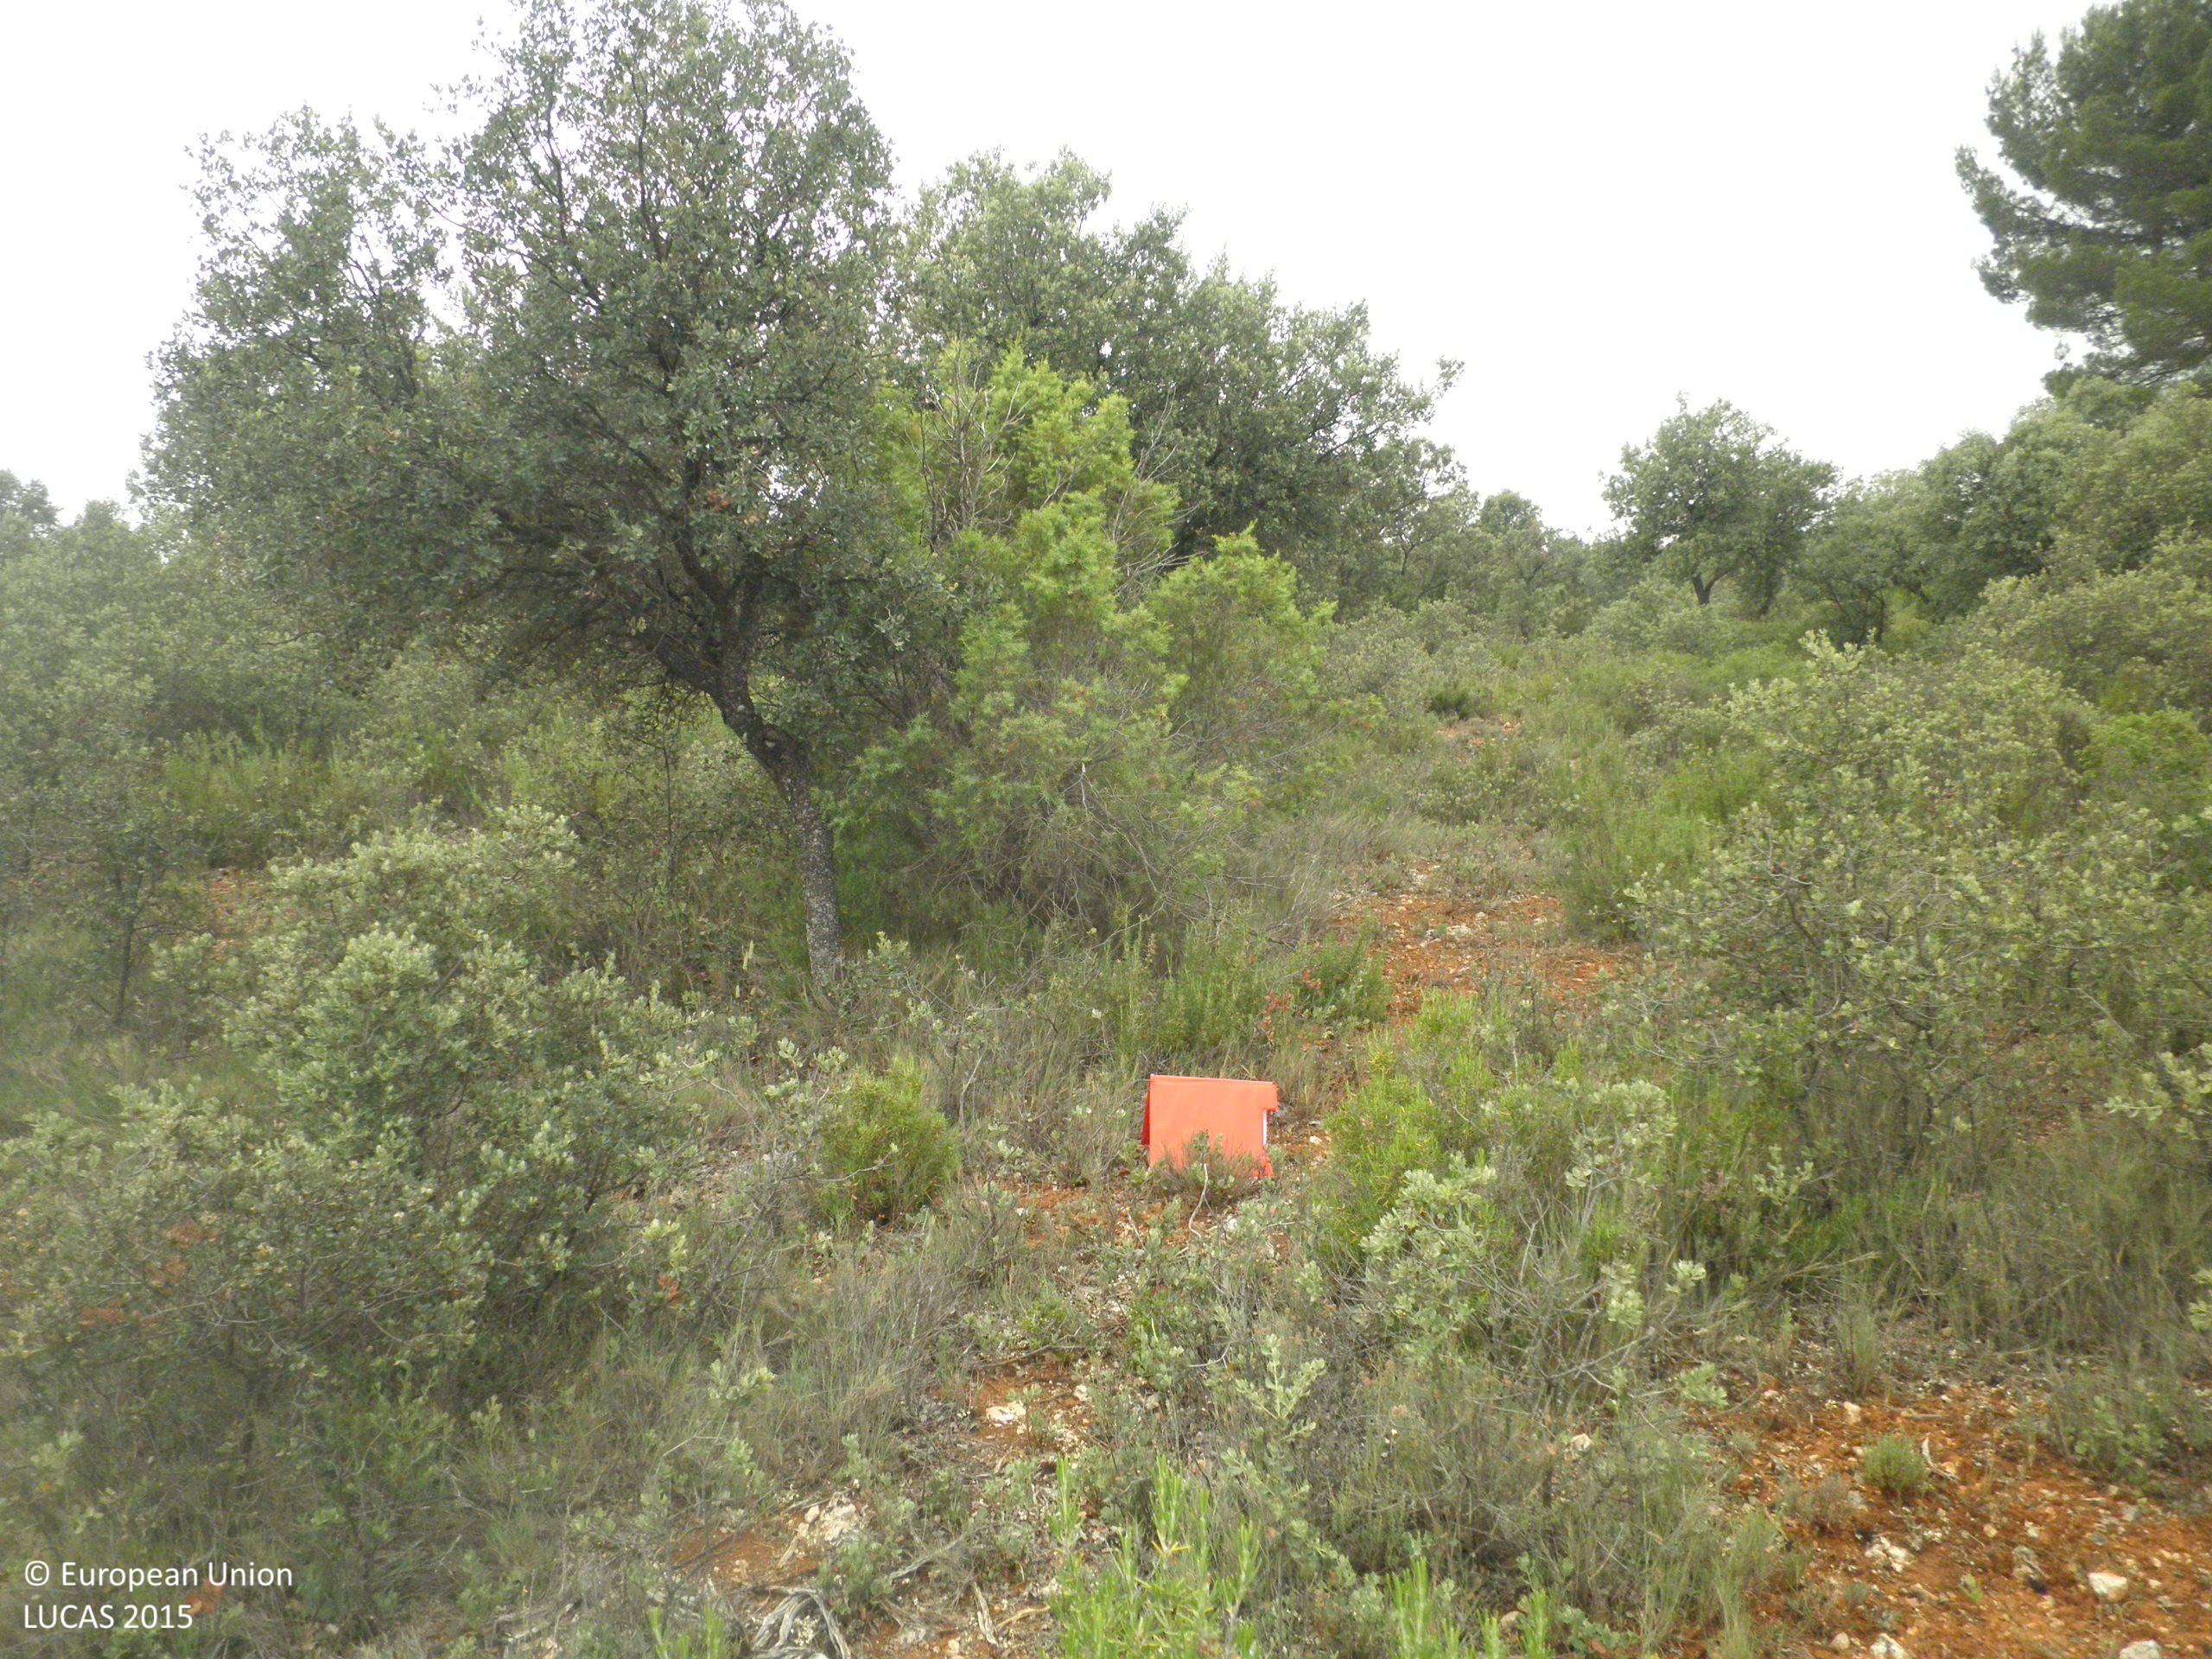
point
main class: Woodland
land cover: Broadleaved woodland
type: broadleaved evergreen forest
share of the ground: 25 - 50 %
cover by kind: shrubs 35 %, unconsolidated bare surface 30 %, broadleaved forest trees 25 %, herbaceous plants 10 %
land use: Semi-natural and natural areas not in use
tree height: < 5 m
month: June
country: ES
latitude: 39.5642
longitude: -1.7041
